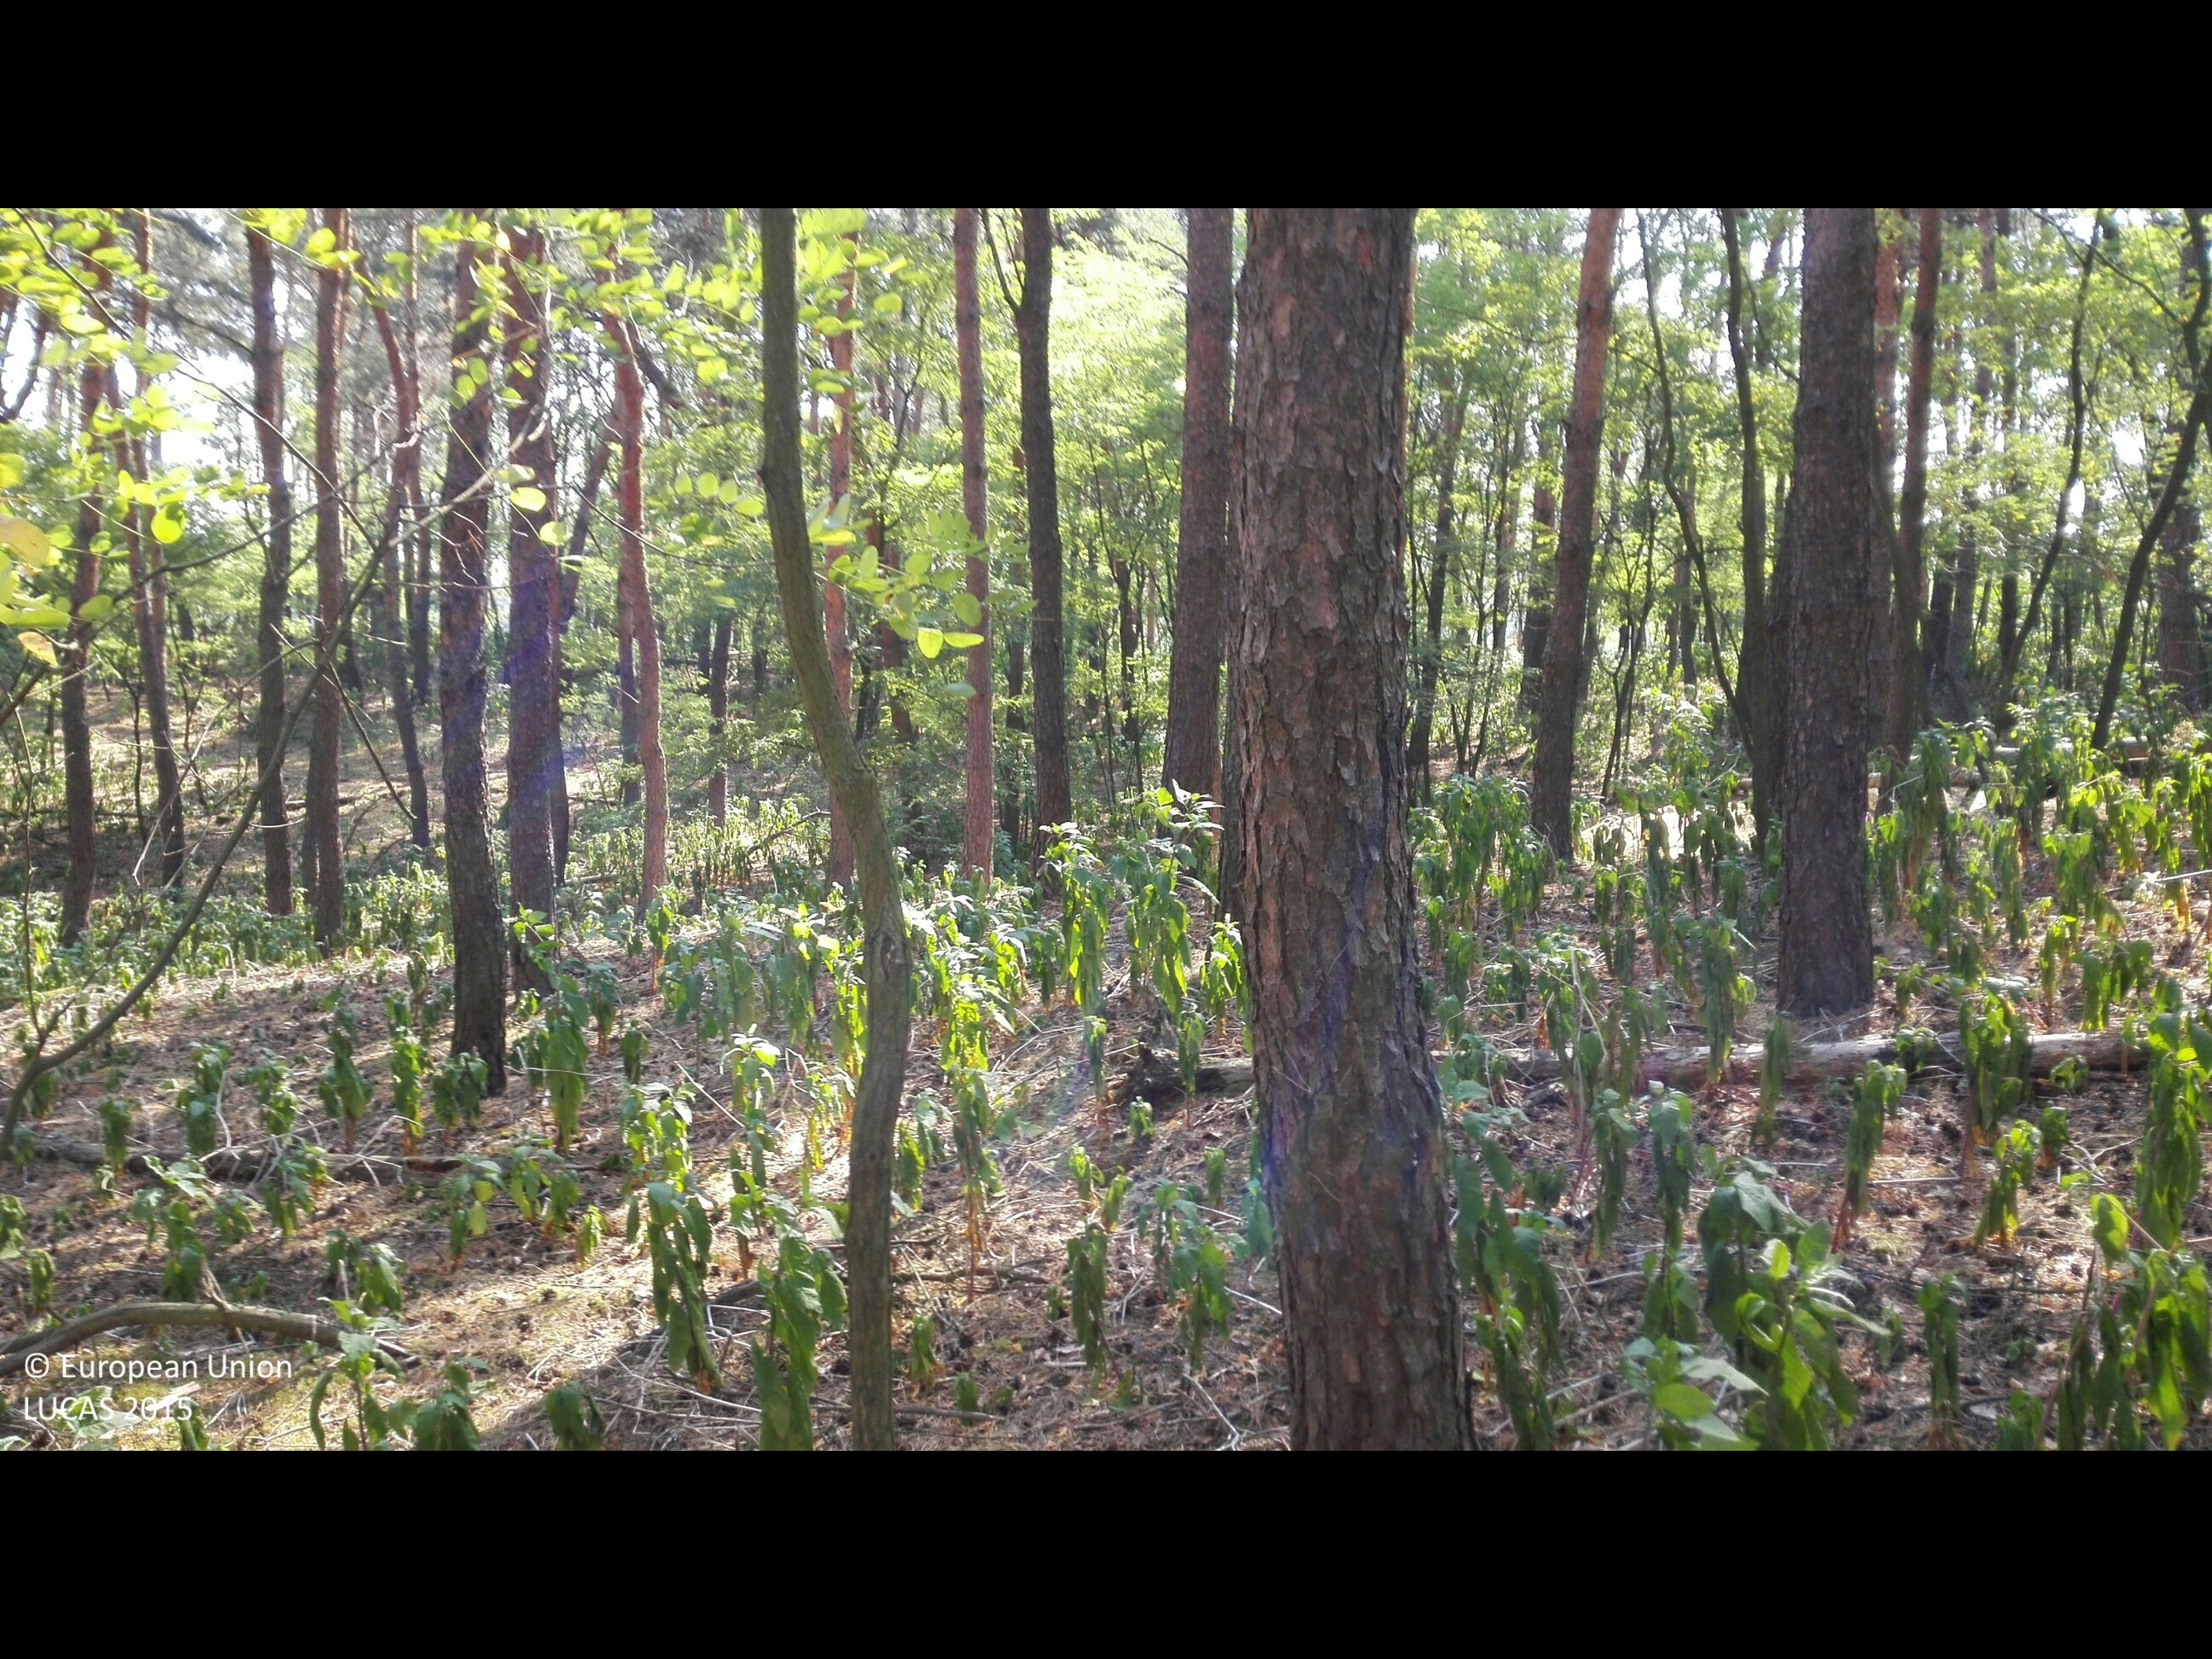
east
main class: Woodland
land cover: Pine dominated mixed woodland
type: hemiboreal forest and nemoral coniferous forest and mixed broadleaved-coniferous forest
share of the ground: > 75 %
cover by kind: coniferous forest trees 75 %, broadleaved forest trees 25 %
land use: Forestry
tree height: > 5 m
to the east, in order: Pine dominated mixed woodland; Tracks; Grassland with sparse tree/shrub cover; Broadleaved woodland
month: August
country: HU
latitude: 47.5947
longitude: 21.8981
